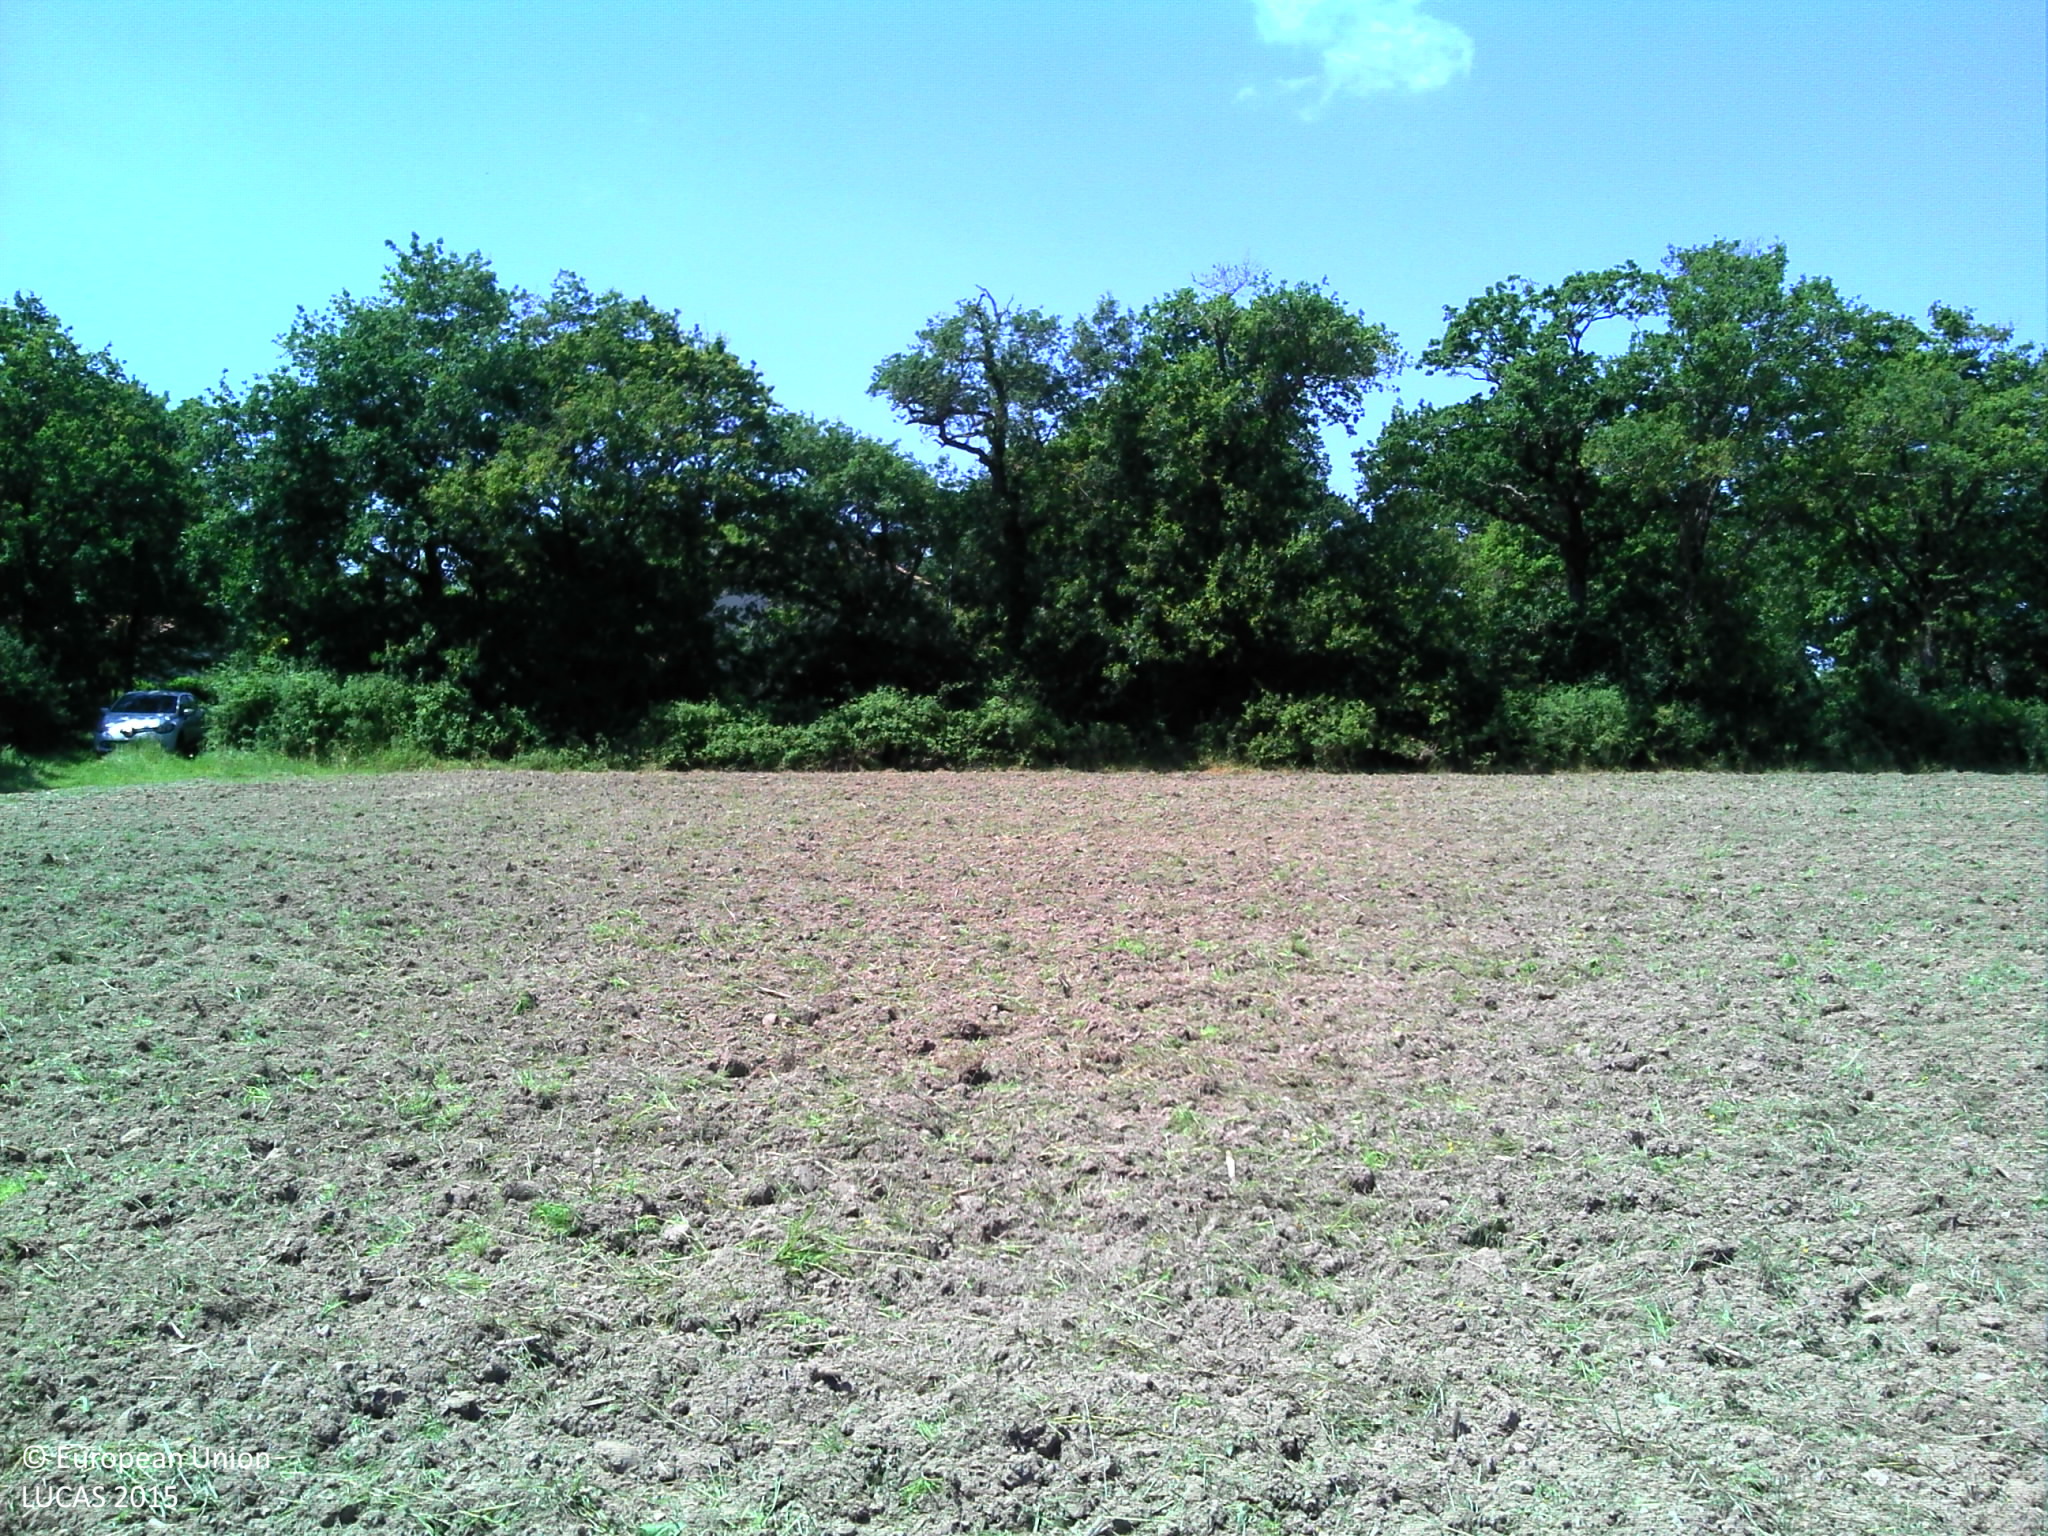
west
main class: Cropland
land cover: Temporary grasslands
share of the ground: 10 - 25 %
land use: Agriculture (excluding fallow land and kitchen gardens)
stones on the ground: < 10 %
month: June
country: FR
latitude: 47.0334
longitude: -1.8757
